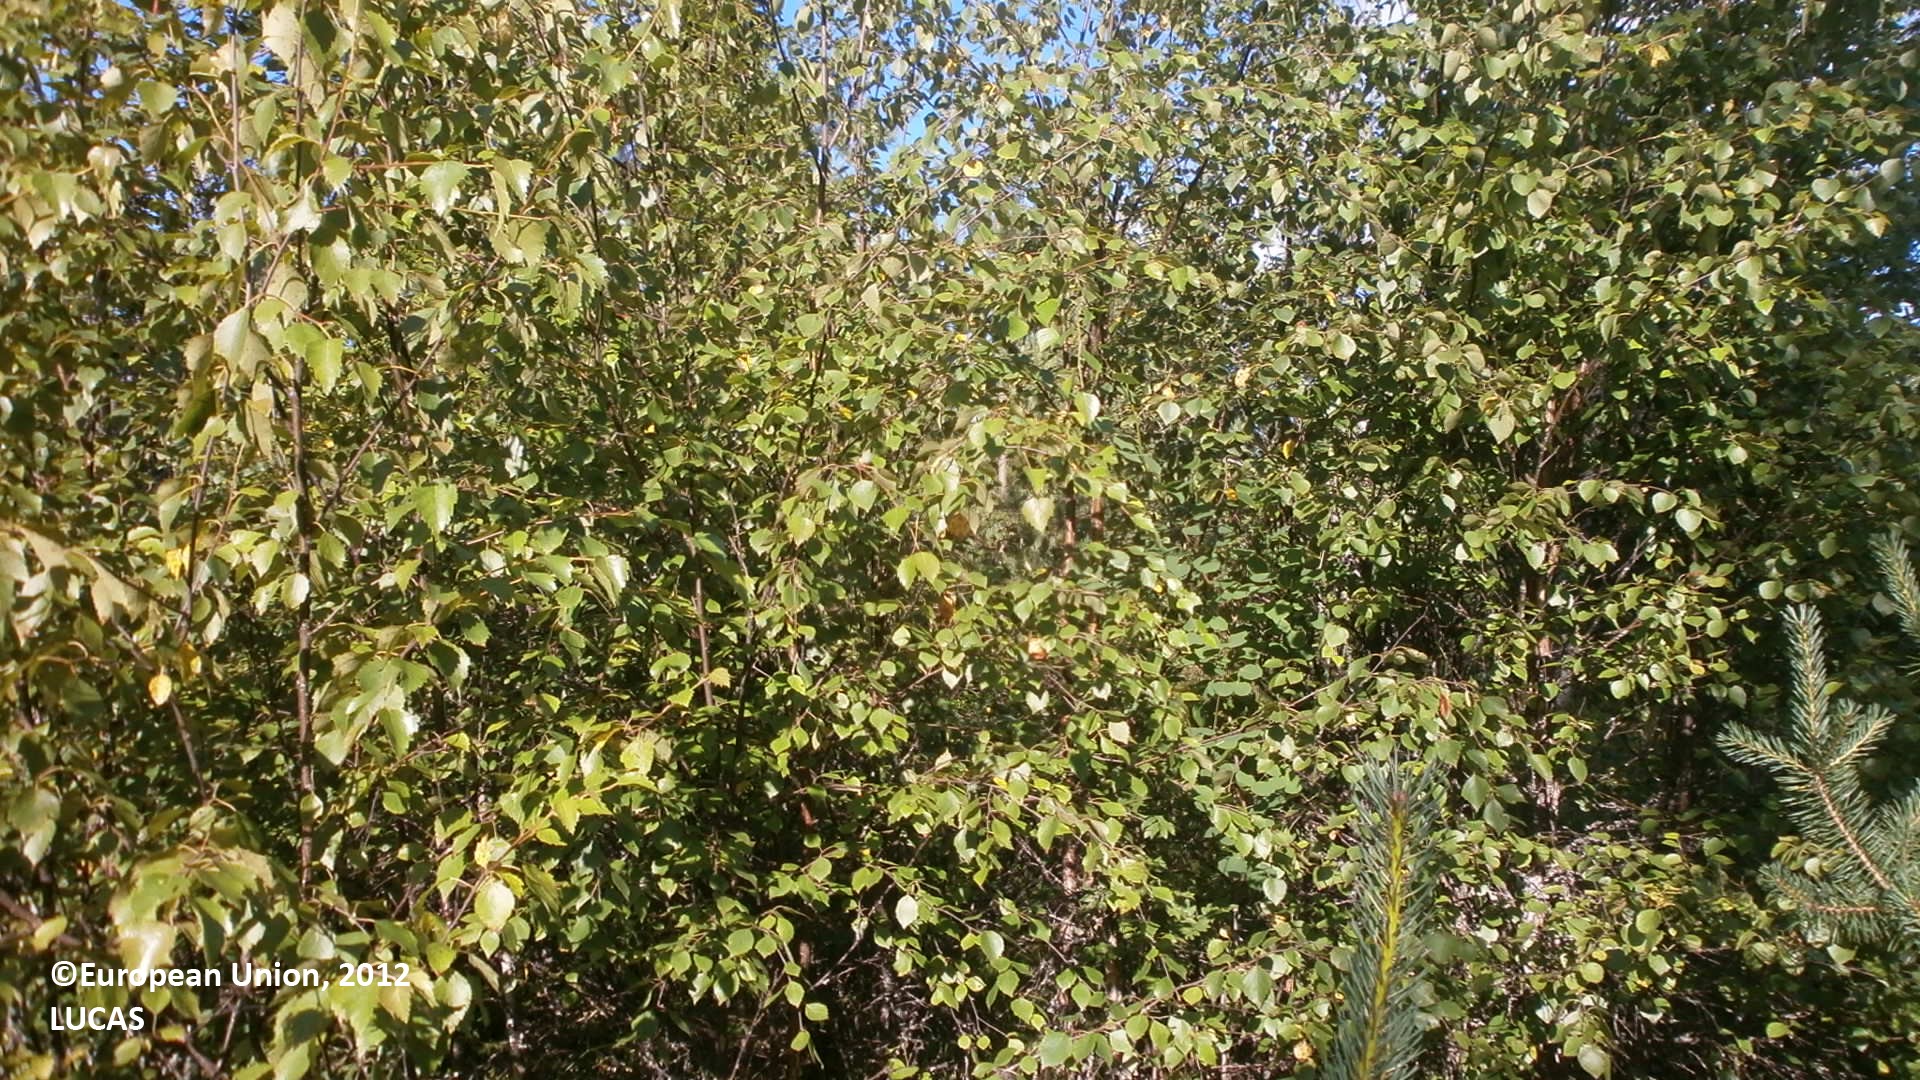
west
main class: Woodland
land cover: Pine dominated mixed woodland
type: boreal forest
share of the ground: 50 - 75 %
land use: Forestry
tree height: > 5 m
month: July
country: FI
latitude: 64.0764
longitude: 24.1103
